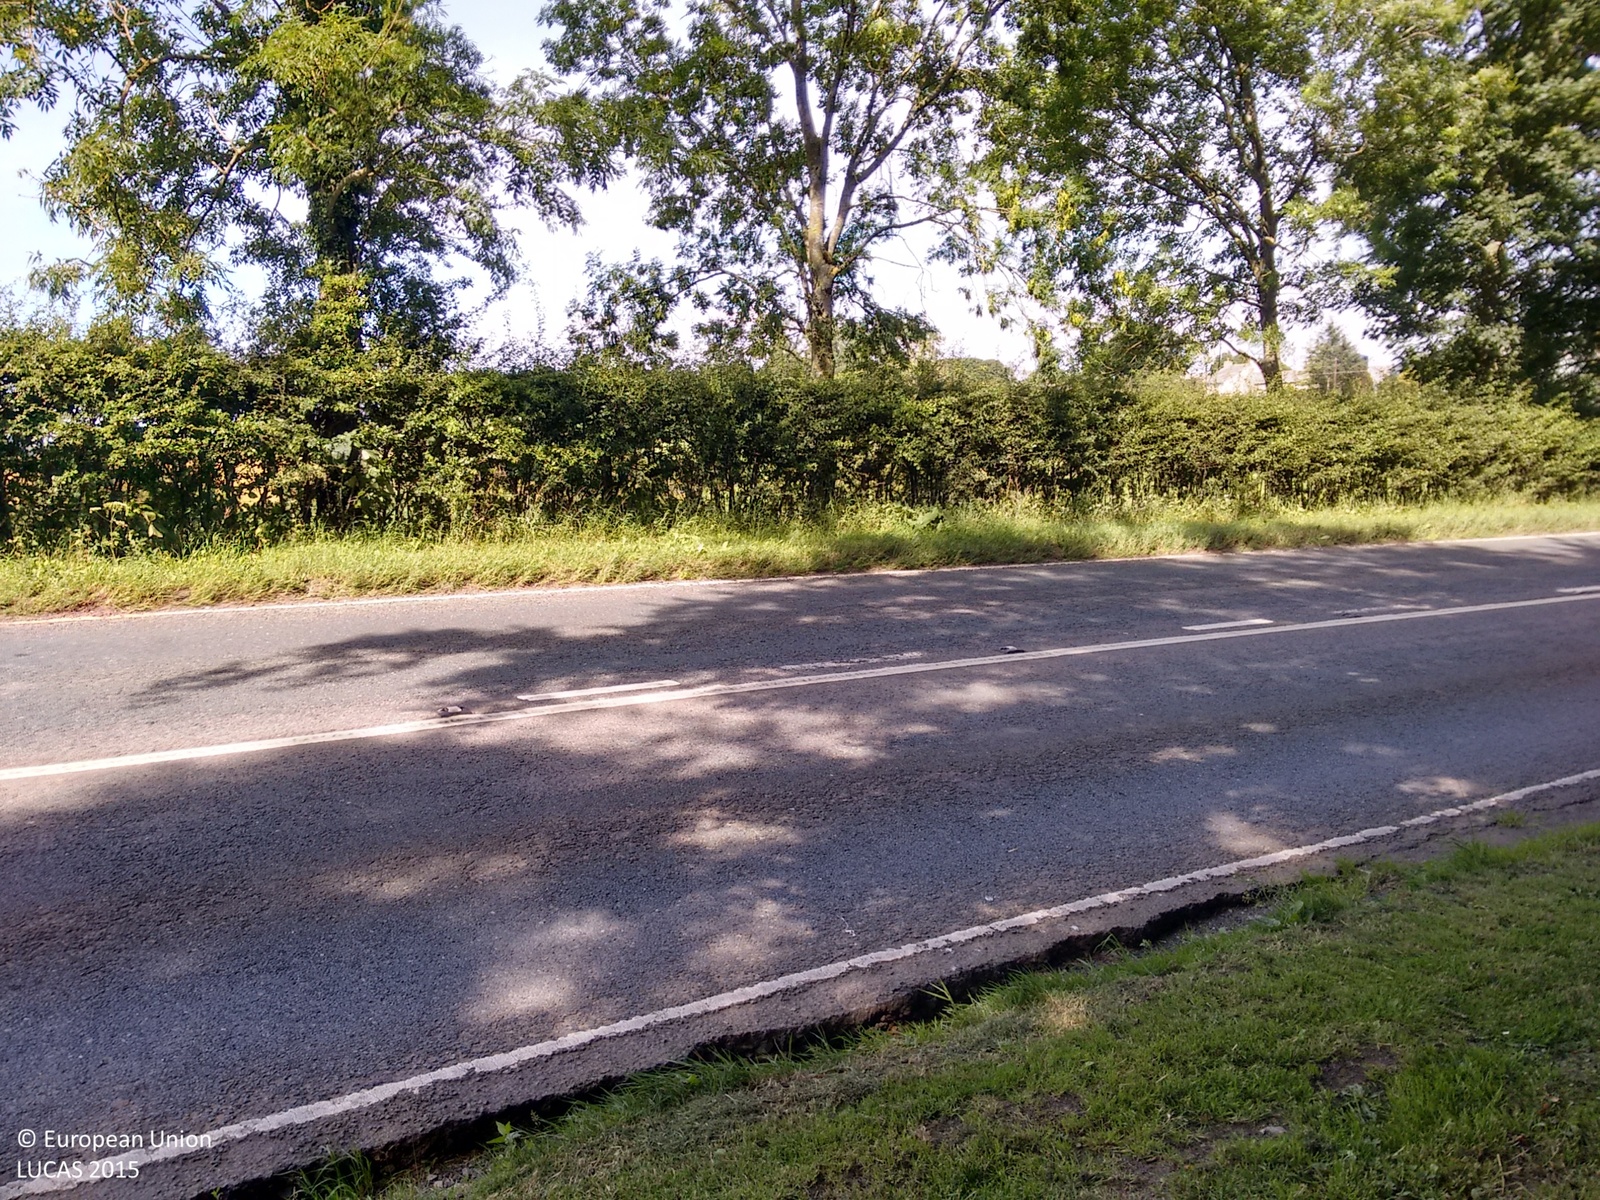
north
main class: Woodland
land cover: Broadleaved woodland
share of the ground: > 75 %
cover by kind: broadleaved forest trees 70 %, herbaceous plants 30 %
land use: Agriculture (excluding fallow land and kitchen gardens)
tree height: > 5 m
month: August
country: GB
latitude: 54.7468
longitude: -3.2662
